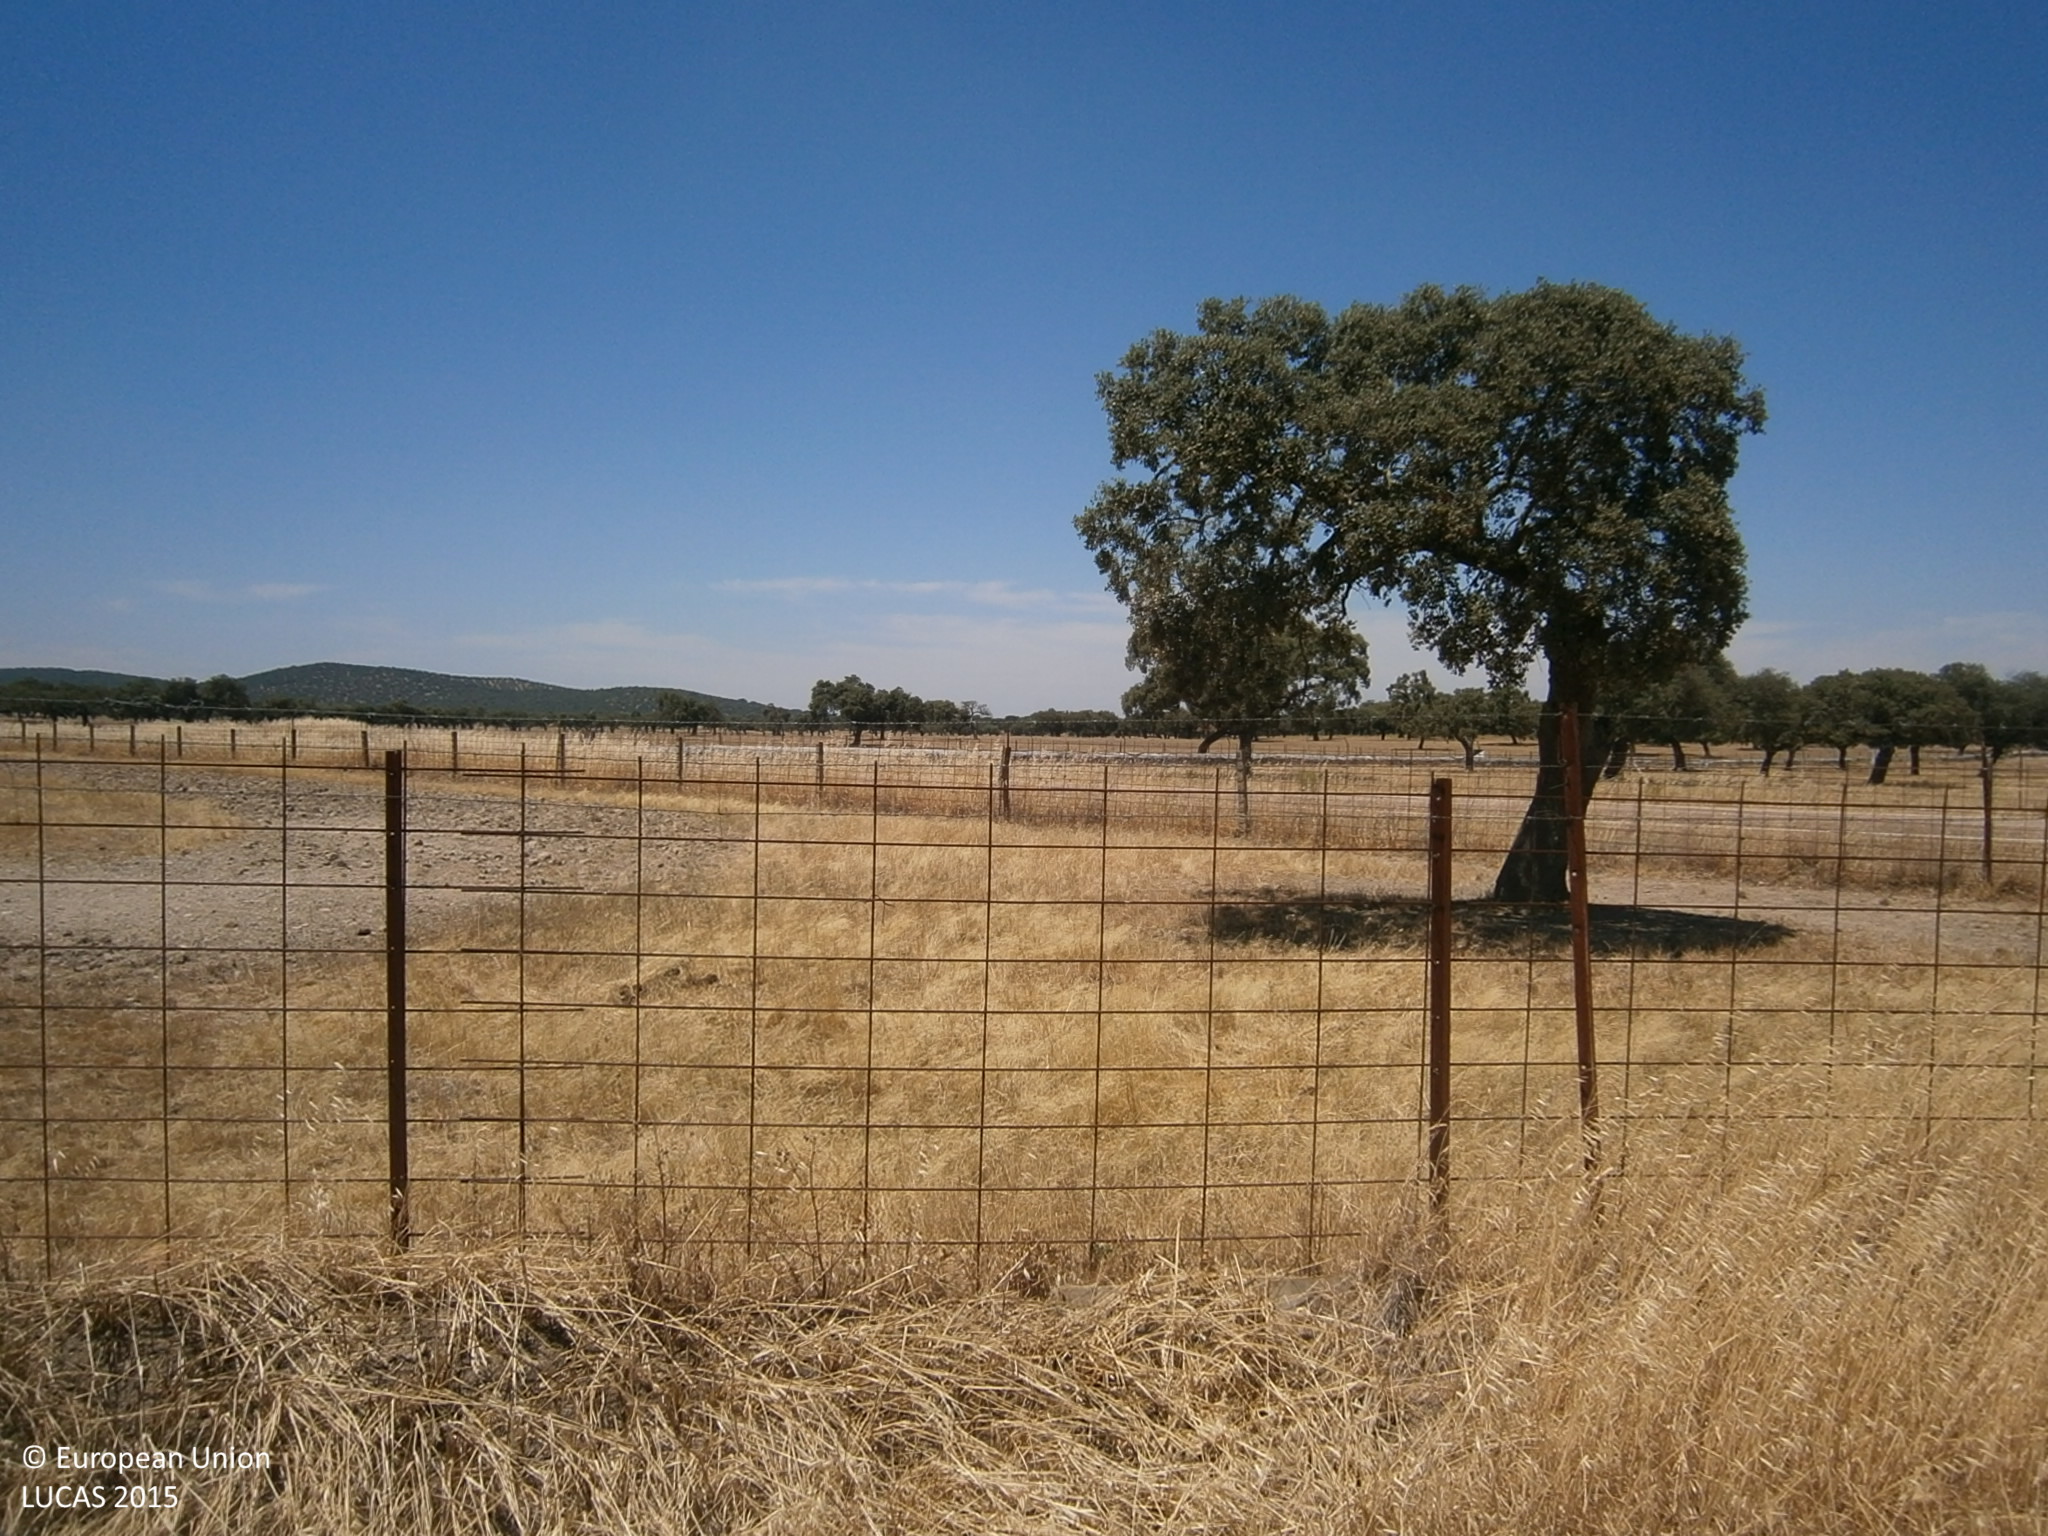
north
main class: Grassland
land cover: Grassland with sparse tree/shrub cover
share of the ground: > 75 %
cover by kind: herbaceous plants 90 %, broadleaved forest trees 5 %, shrubs 5 %
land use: Agriculture (excluding fallow land and kitchen gardens)
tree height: > 5 m
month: June
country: ES
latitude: 38.6288
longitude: -6.8684
